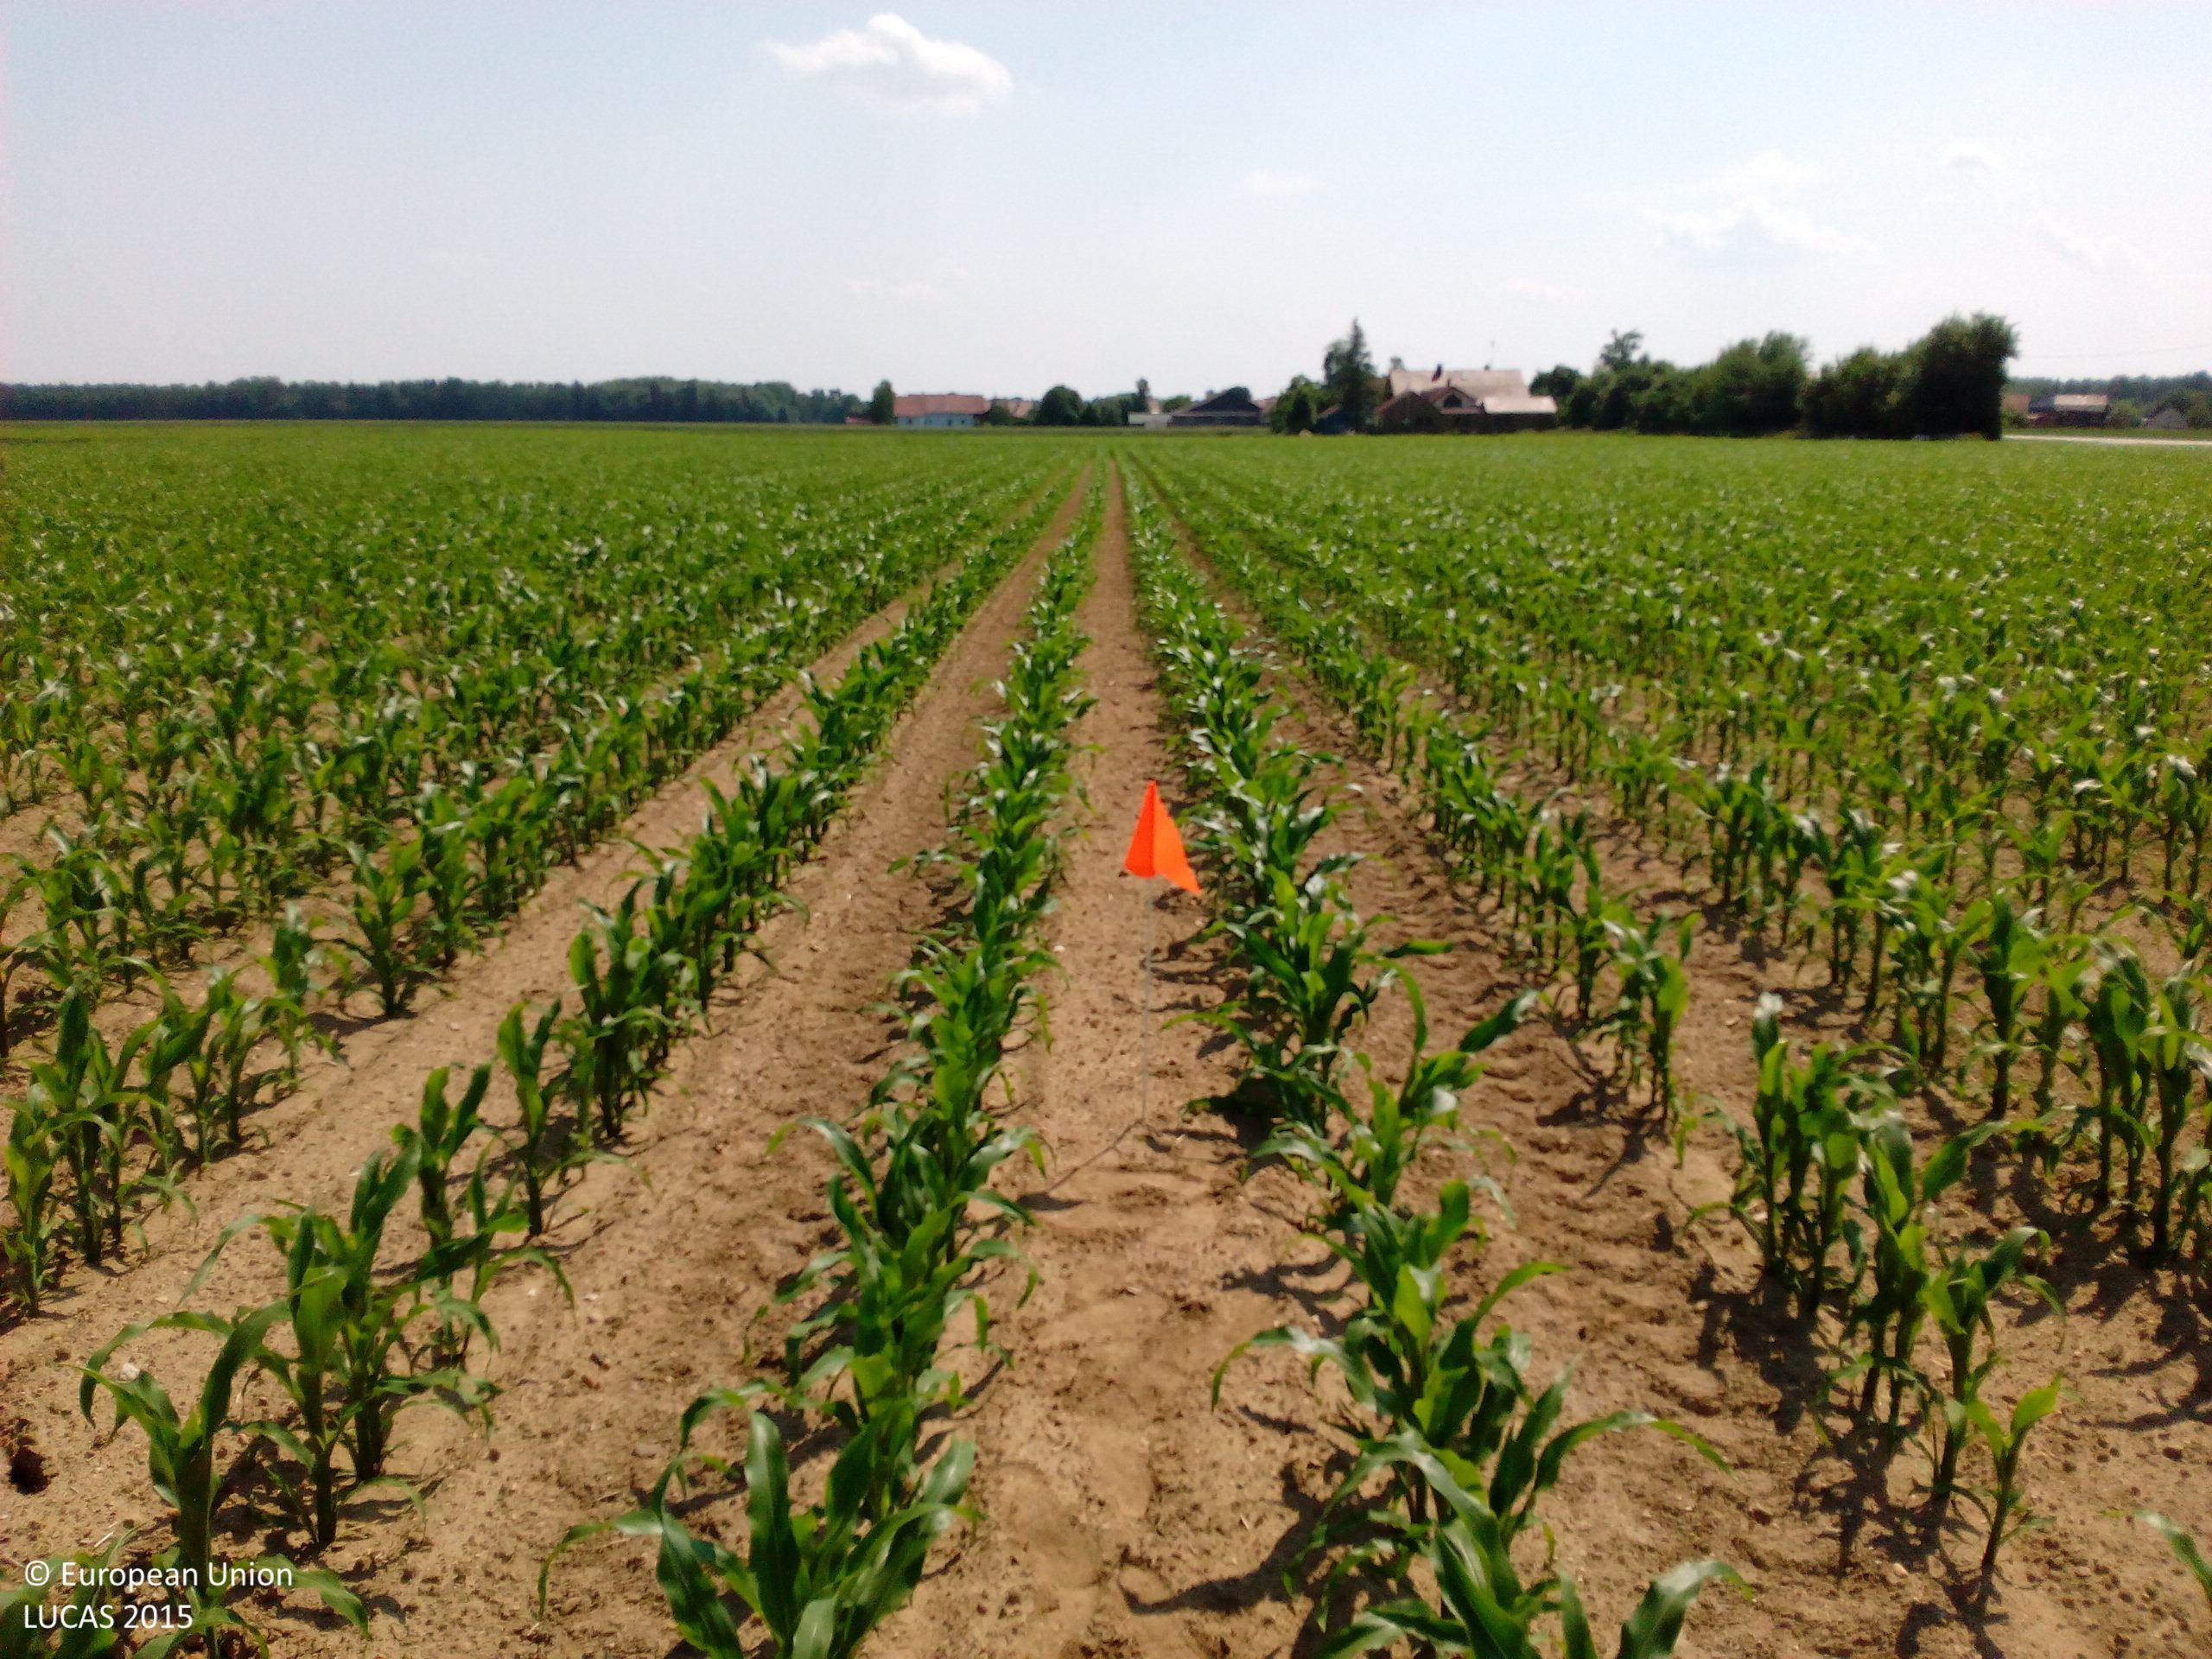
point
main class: Cropland
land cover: Maize
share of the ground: 10 - 25 %
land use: Agriculture (excluding fallow land and kitchen gardens)
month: June
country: DE
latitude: 48.9531
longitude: 12.4165
